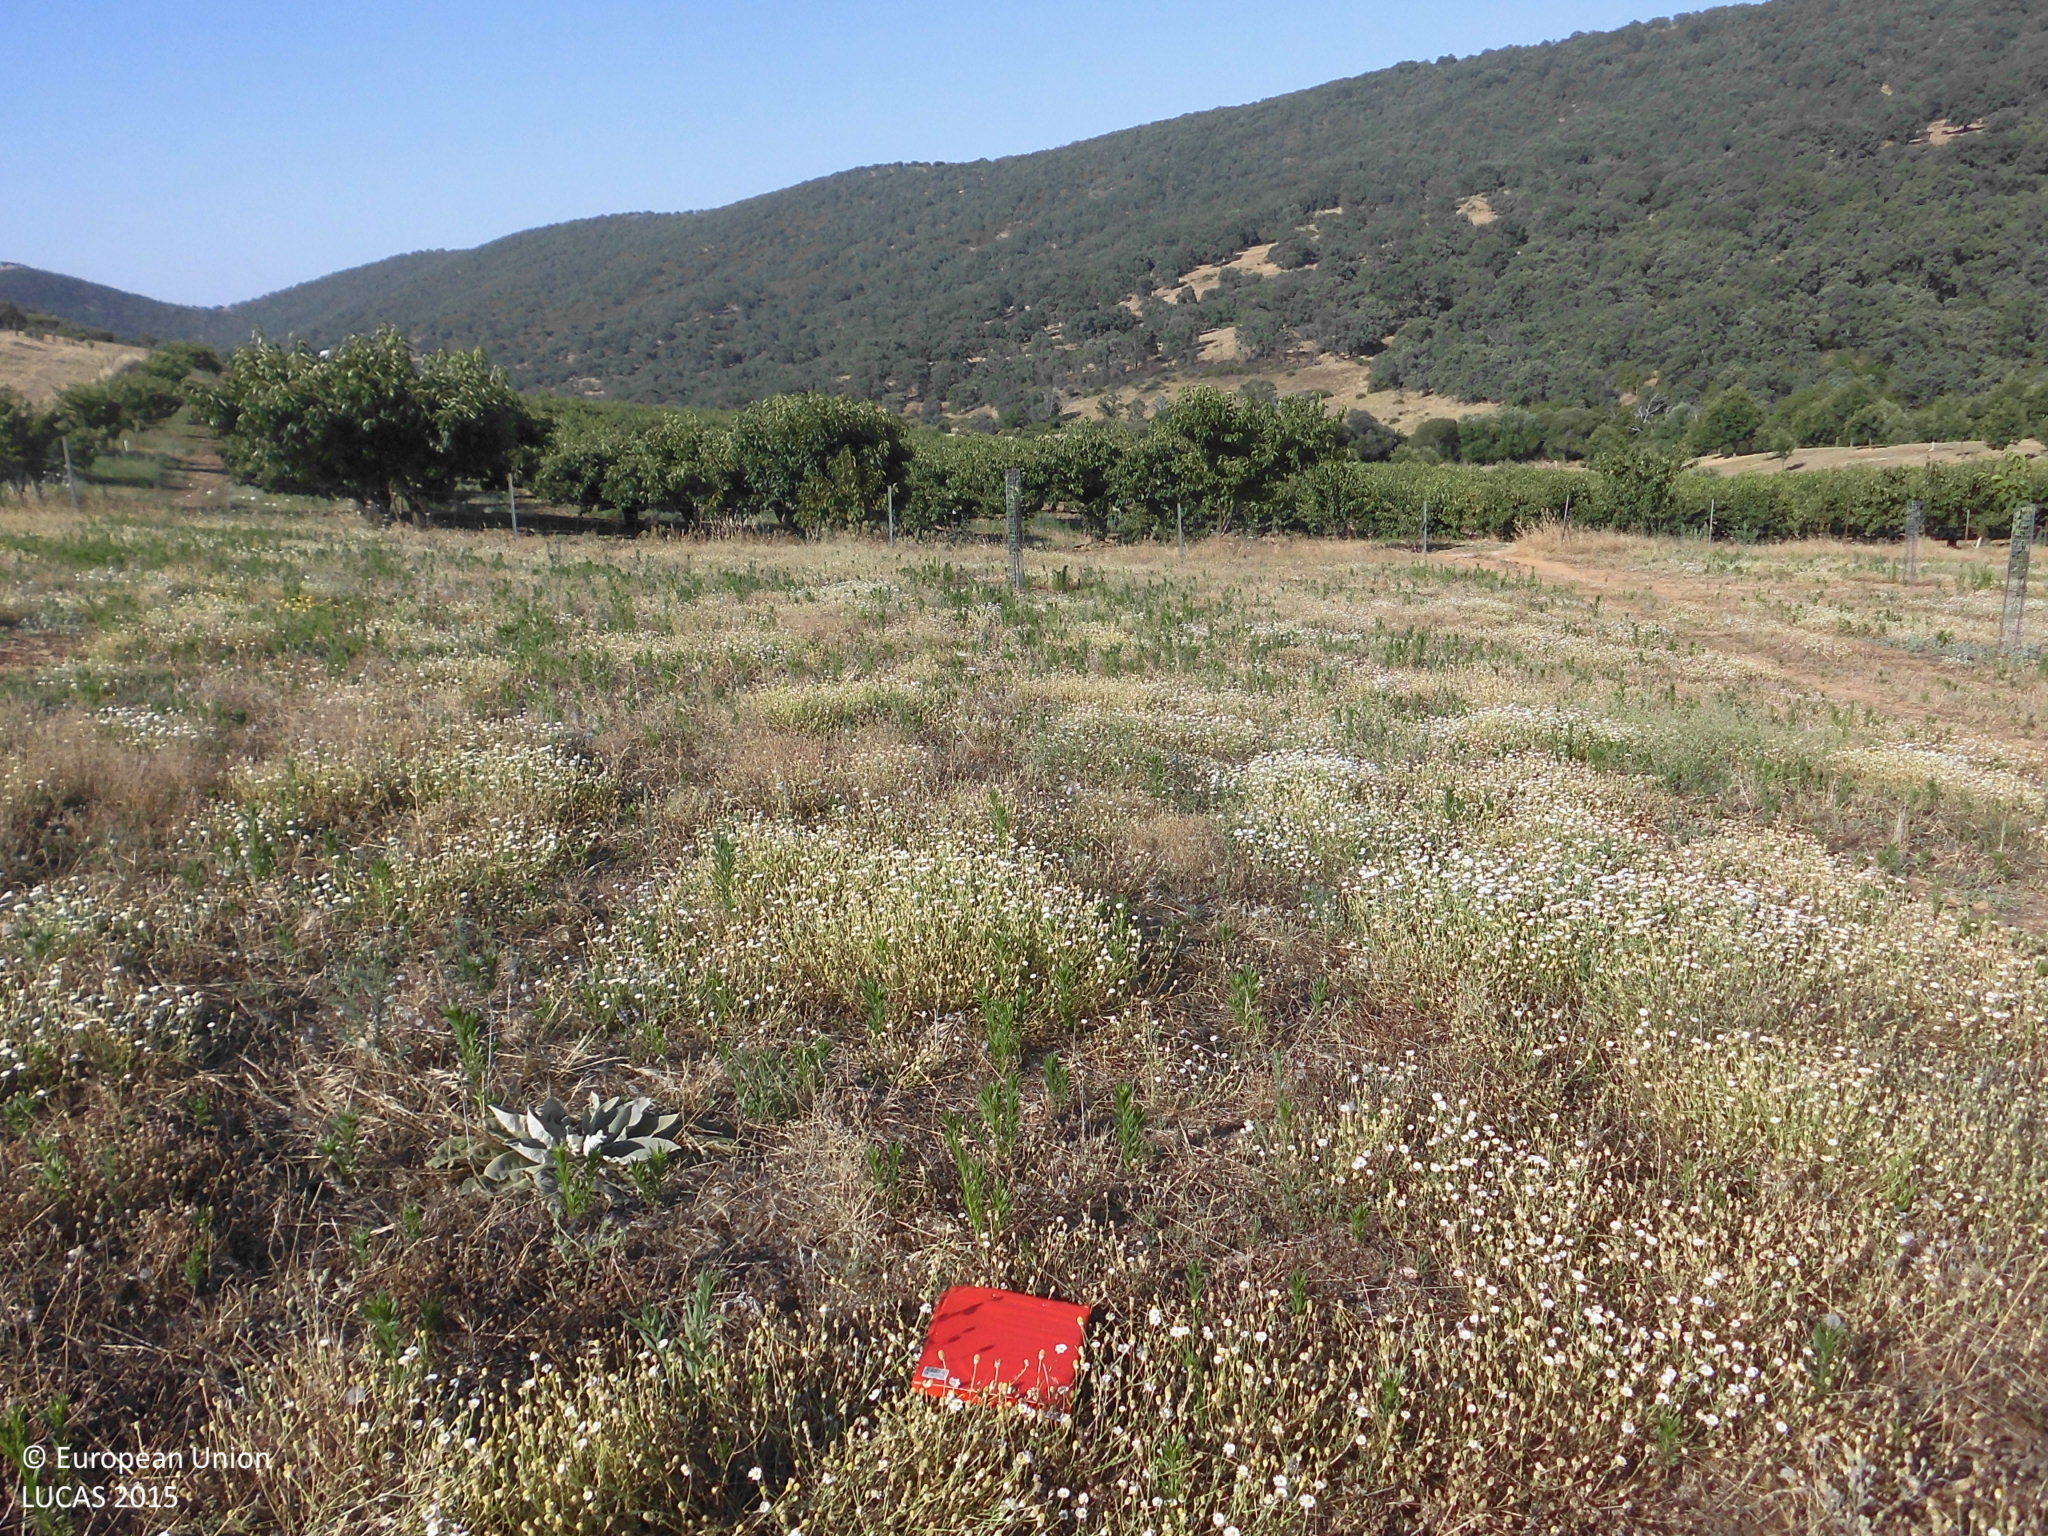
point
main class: Cropland
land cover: Nuts trees
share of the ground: < 10 %
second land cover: Grassland without tree/shrub cover
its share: > 75 %
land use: Agriculture (excluding fallow land and kitchen gardens)
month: July
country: ES
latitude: 39.4044
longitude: -5.5548
